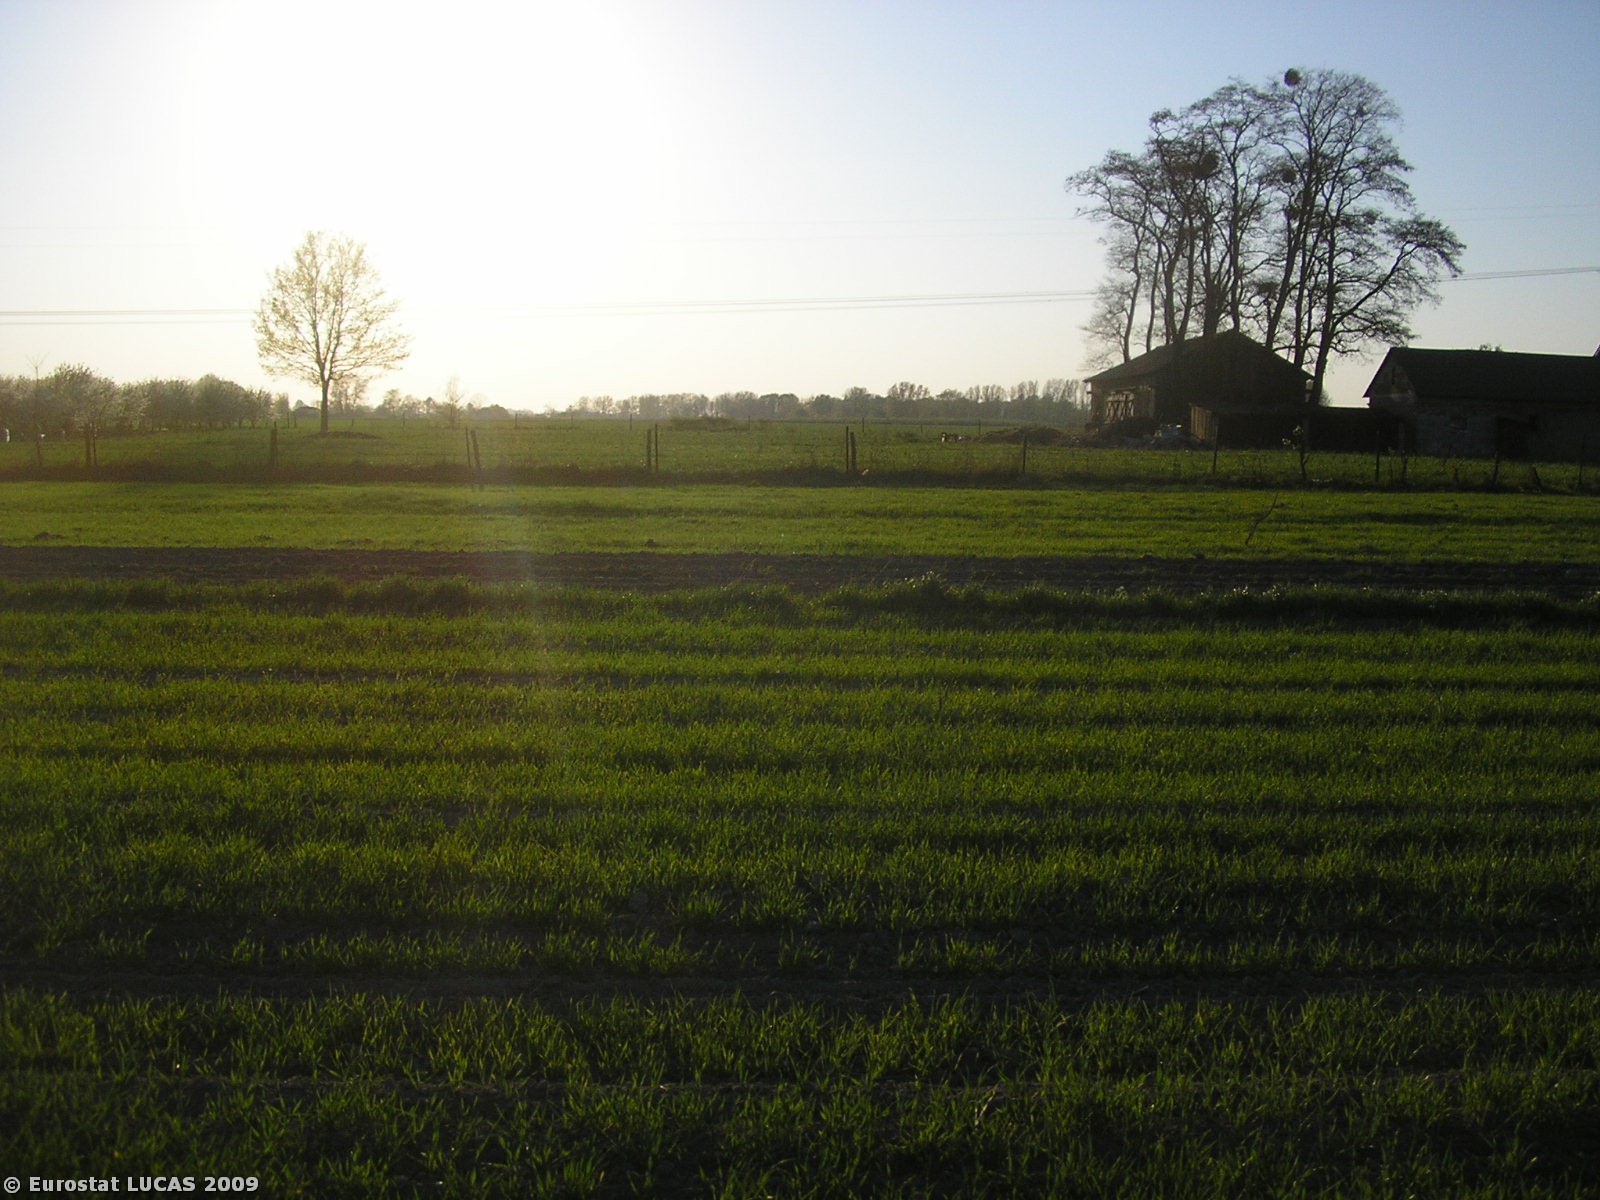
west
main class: Cropland
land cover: Mixed cereals for fodder
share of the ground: 25 - 50 %
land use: Agriculture (excluding fallow land and kitchen gardens)
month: April
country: PL
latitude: 52.2336
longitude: 20.1225
